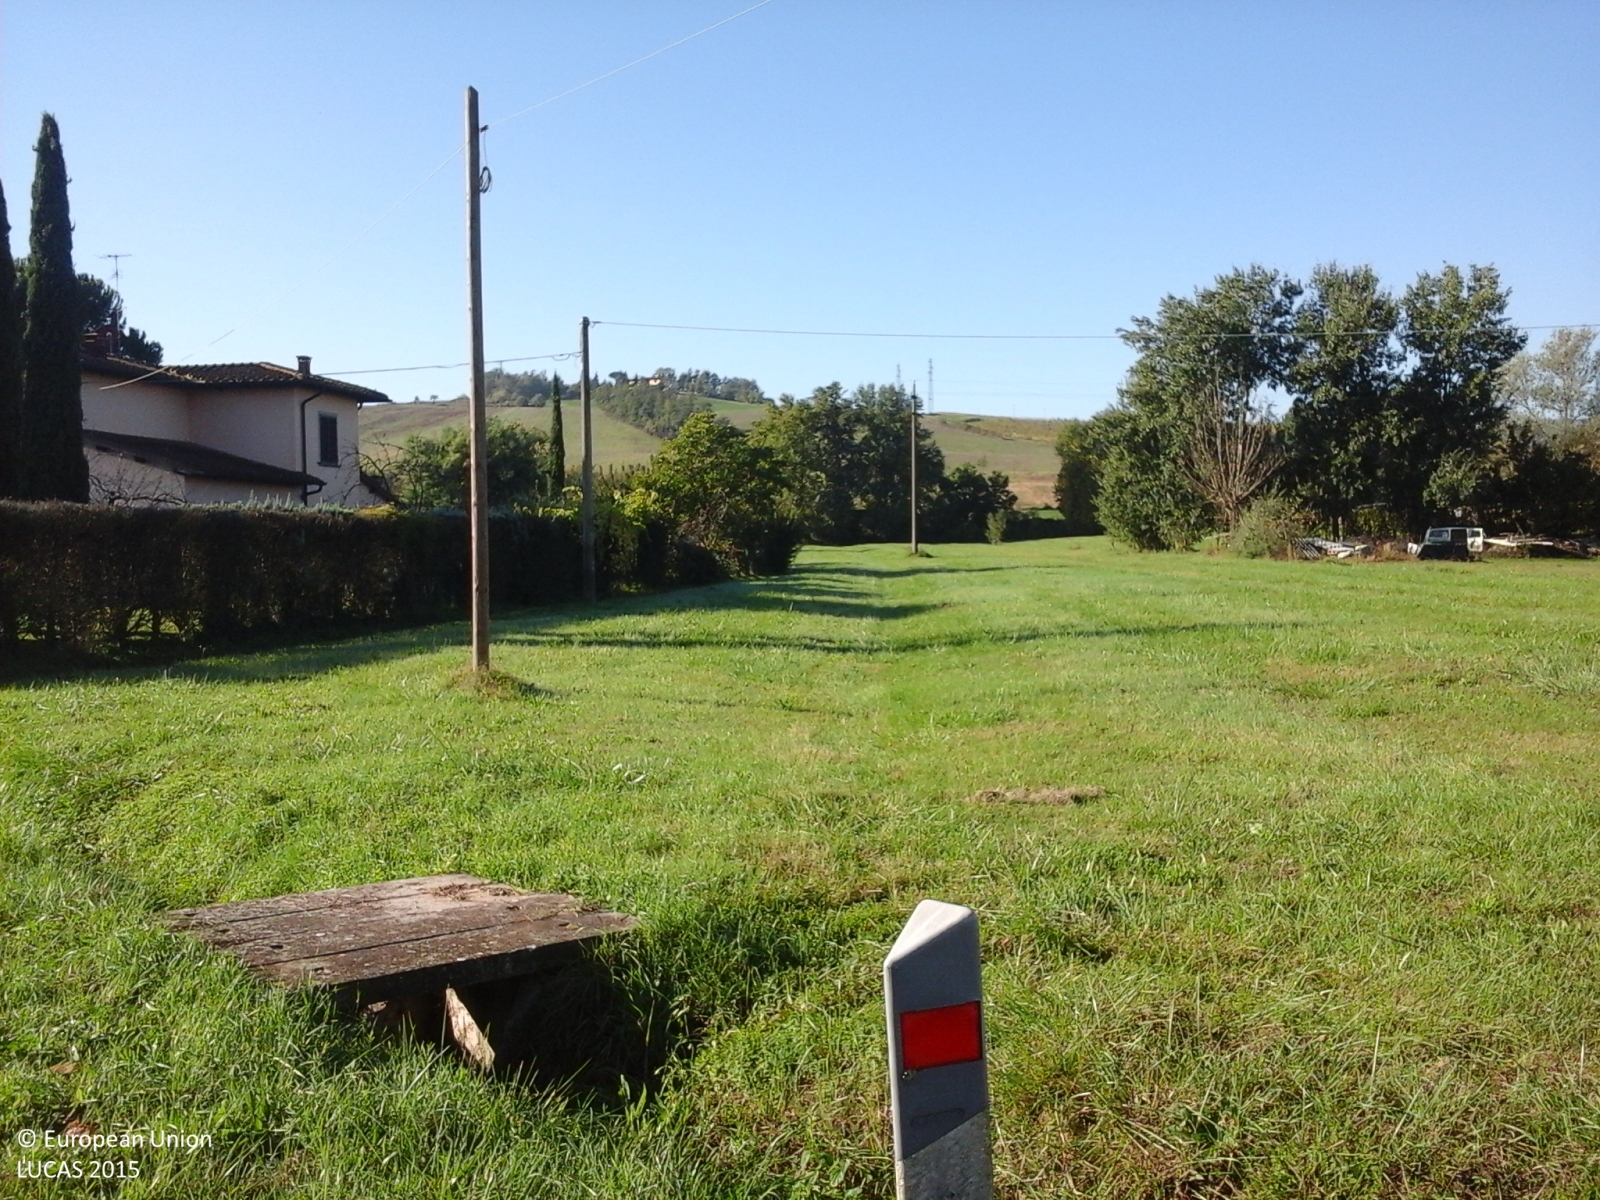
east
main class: Grassland
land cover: Grassland without tree/shrub cover
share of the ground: > 75 %
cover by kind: herbaceous plants 100 %
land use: Agriculture (excluding fallow land and kitchen gardens)
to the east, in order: Grassland without tree/shrub cover; Electric lines; Grassland without tree/shrub cover; Managed hedges; Grassland with sparse tree/shrub cover; Electric lines; Grassland with sparse tree/shrub cover; Managed hedges; Grass margins; Paved roads, cycling and walking lanes; Grass margins; Ditches and canals; Grassland without tree/shrub cover; Ditches and canals; Grassland without tree/shrub cover; Lines of trees; Grassland without tree/shrub cover; Lines of trees; Grassland without tree/shrub cover; Ditches and canals; Vineyards
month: October
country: IT
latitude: 43.5451
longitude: 11.5429
